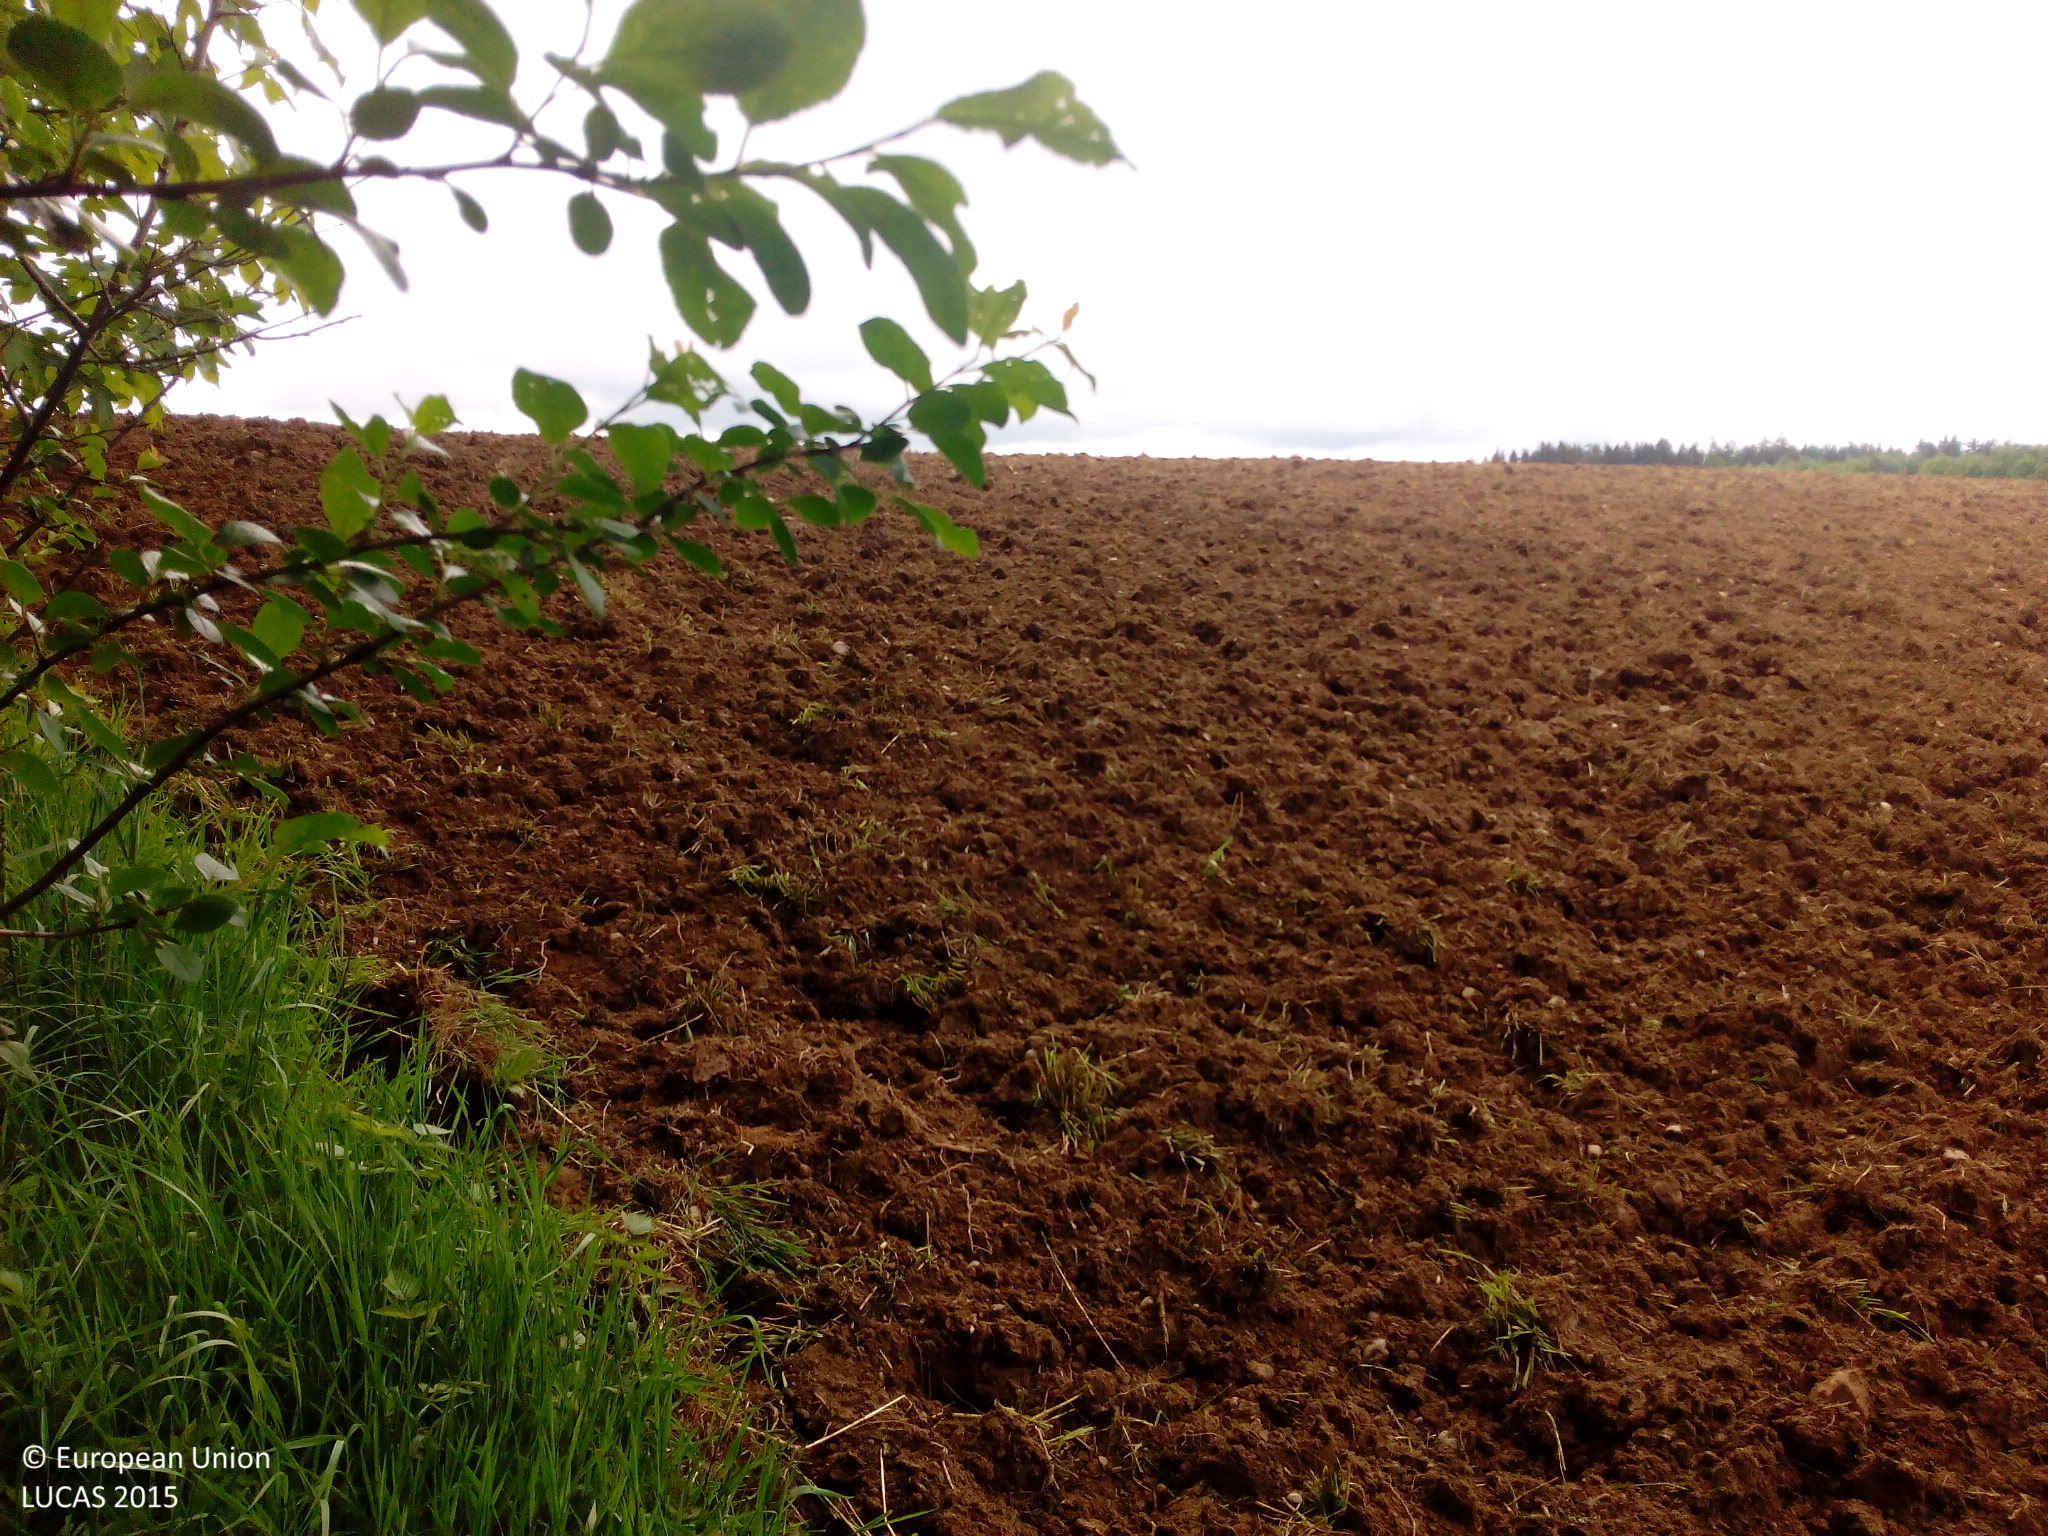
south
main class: Grassland
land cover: Grassland with sparse tree/shrub cover
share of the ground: > 75 %
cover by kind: herbaceous plants 95 %, broadleaved forest trees 5 %
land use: Residential
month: May
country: DE
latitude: 48.1155
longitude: 9.9329
